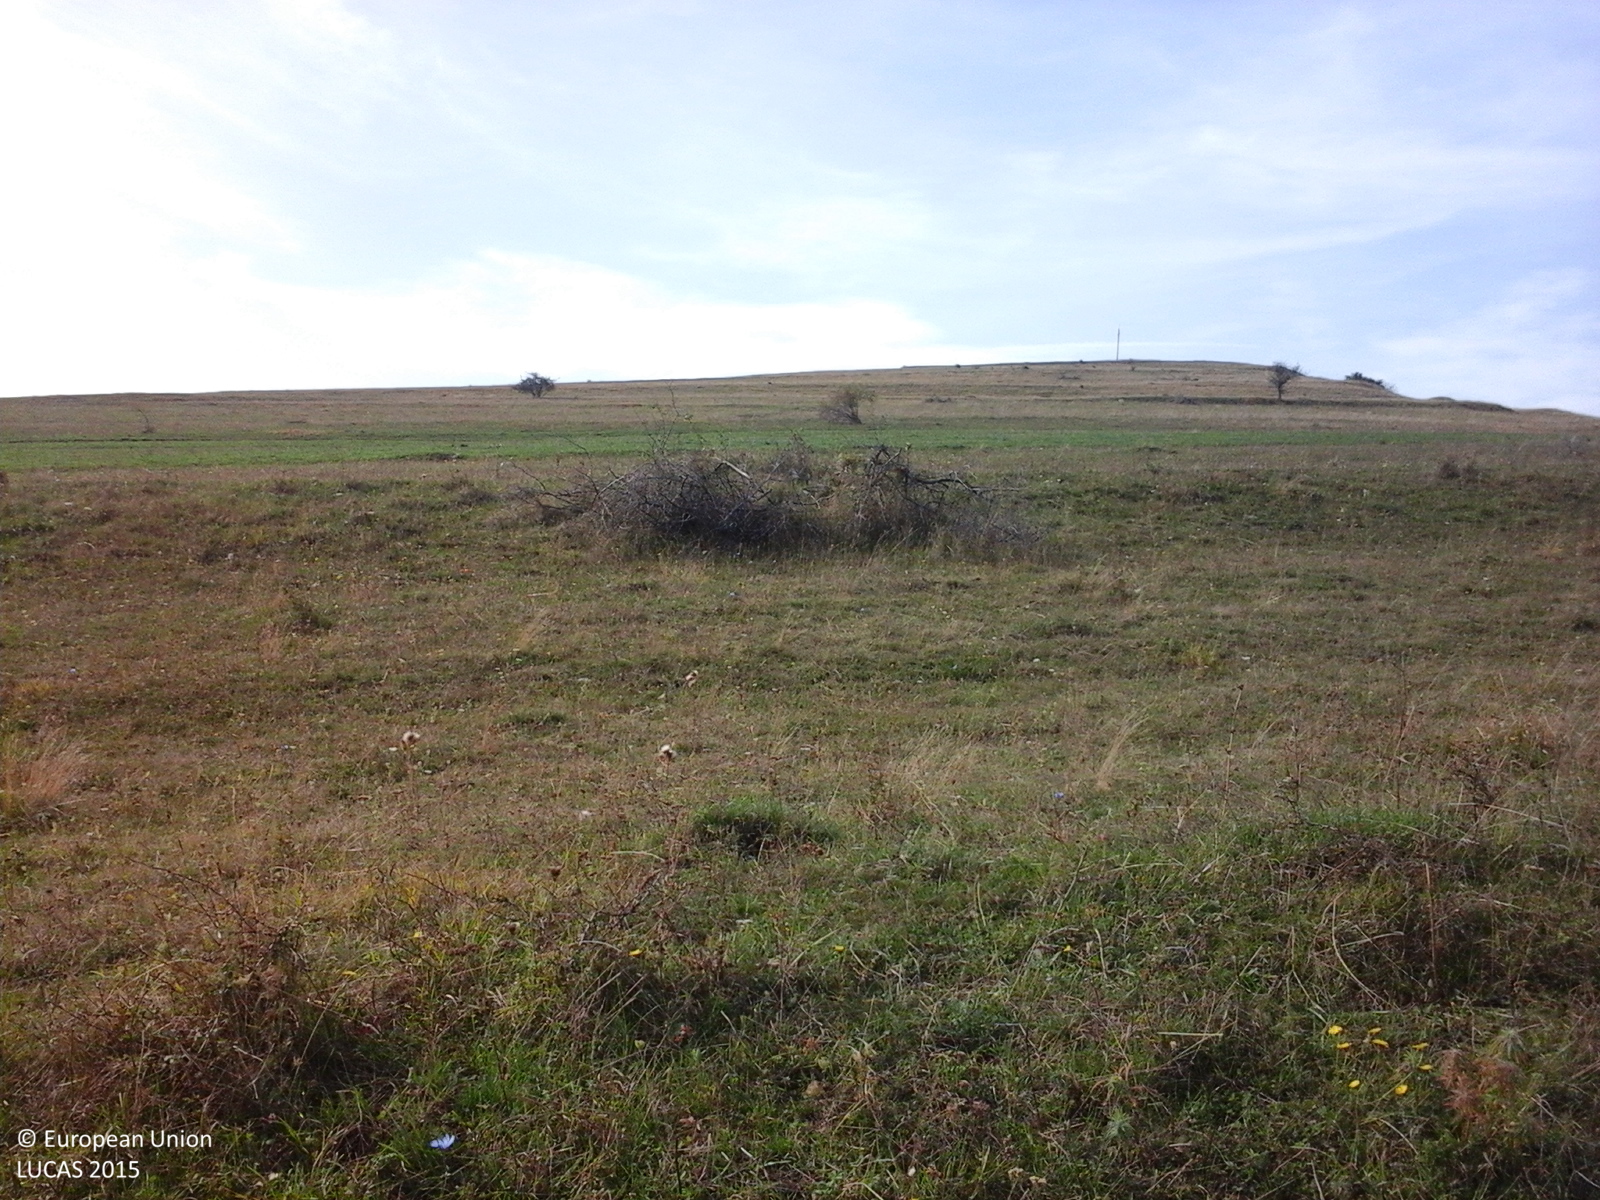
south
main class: Grassland
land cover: Grassland without tree/shrub cover
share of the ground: > 75 %
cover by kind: herbaceous plants 100 %
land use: Agriculture (excluding fallow land and kitchen gardens)
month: September
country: RO
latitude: 46.8240
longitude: 23.3457
